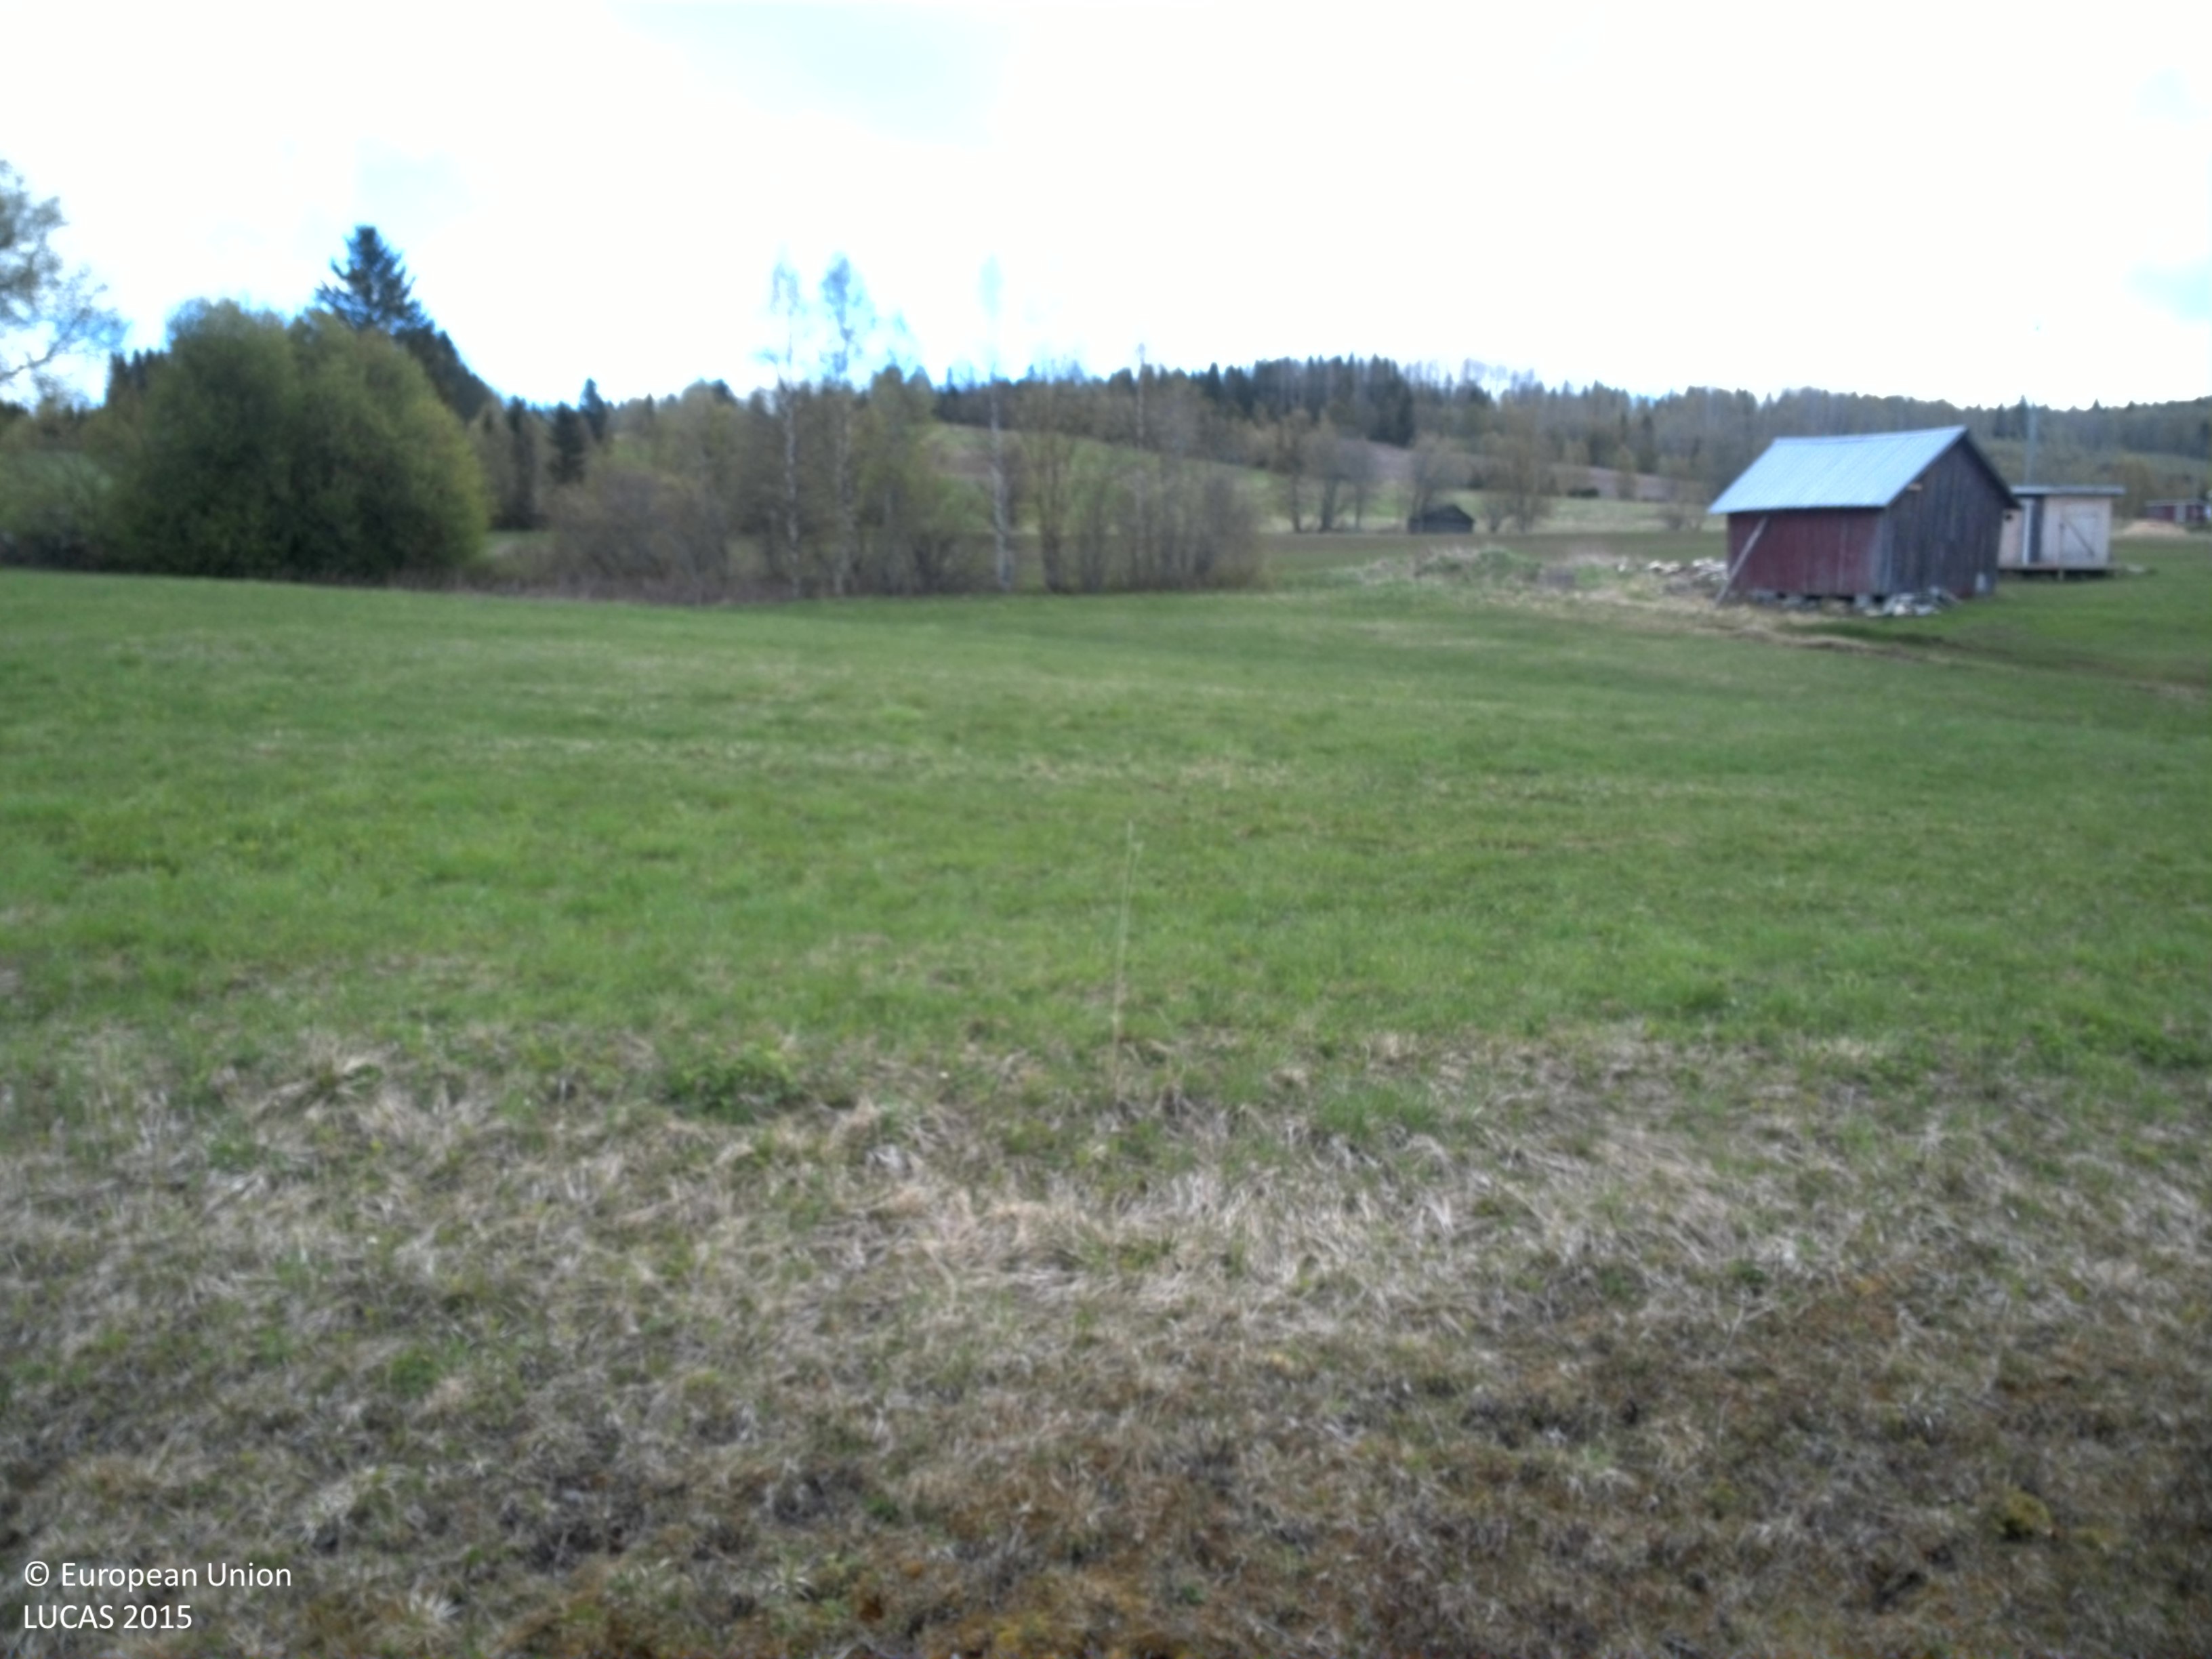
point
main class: Cropland
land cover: Other leguminous and mixtures for fodder
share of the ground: > 75 %
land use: Agriculture (excluding fallow land and kitchen gardens)
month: June
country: SE
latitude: 63.5009
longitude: 13.8973
